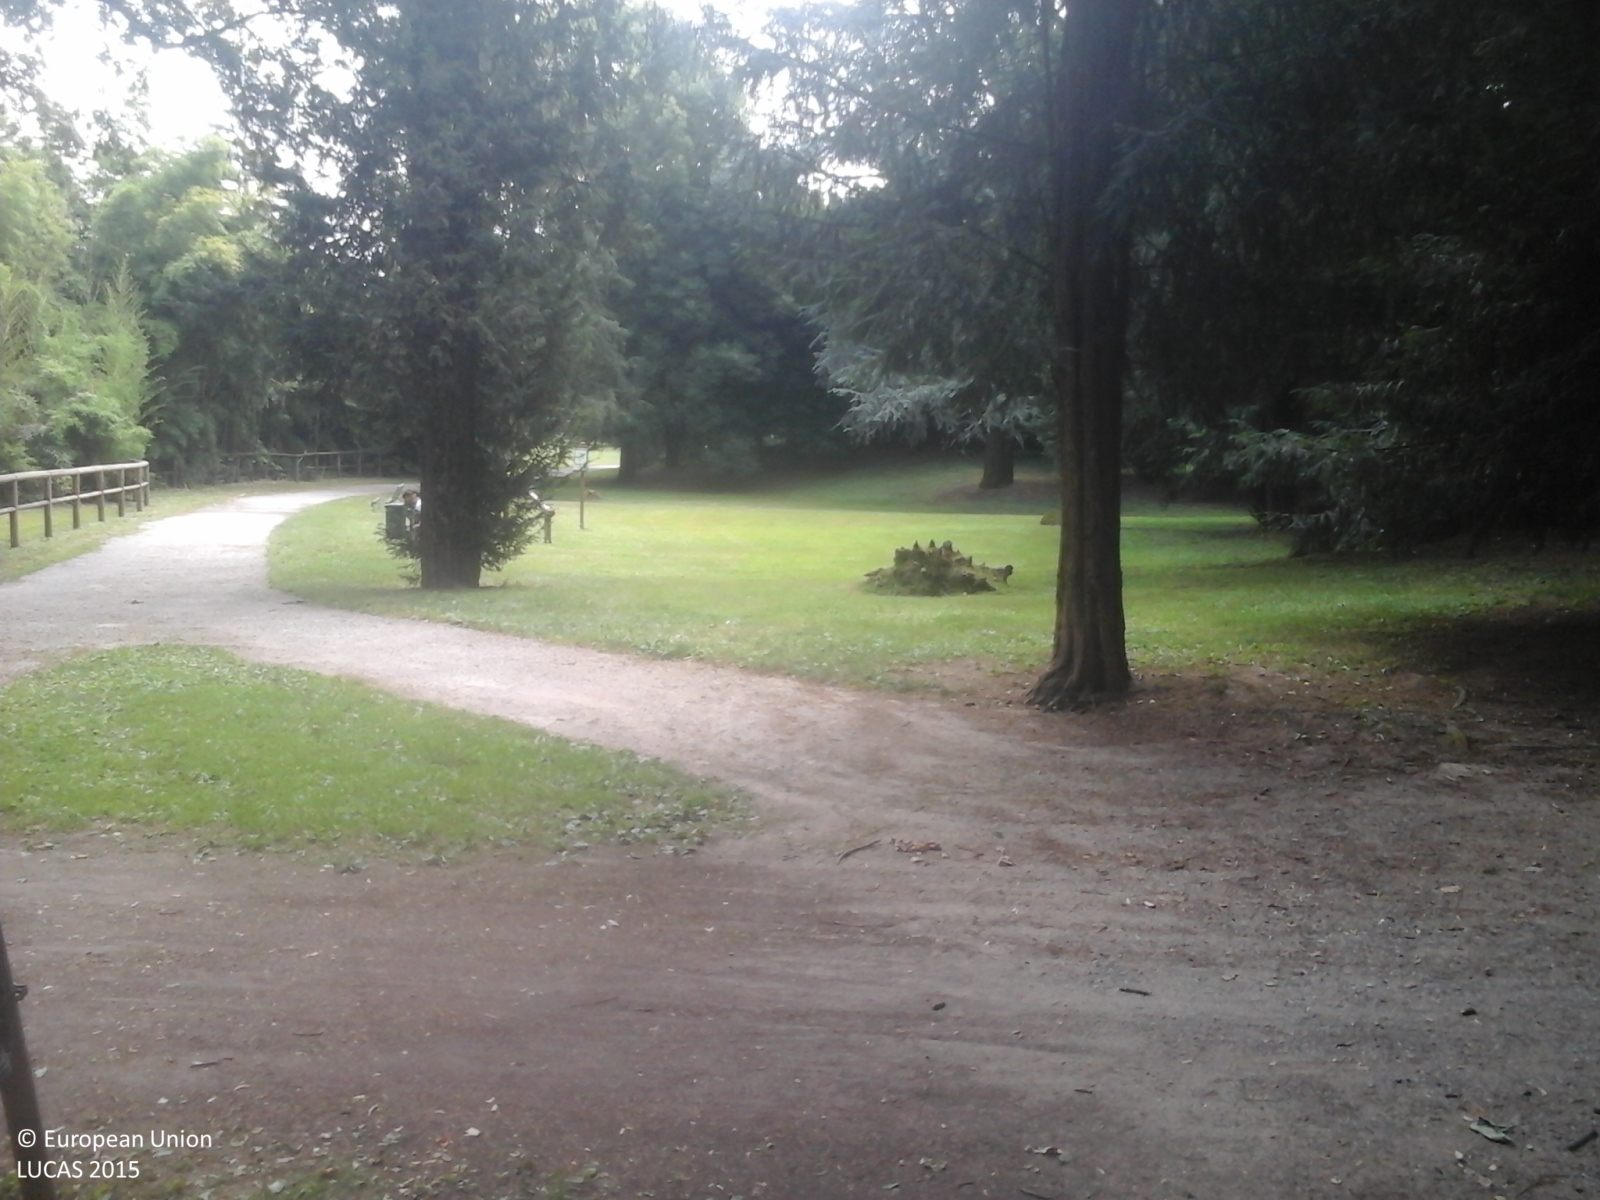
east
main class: Woodland
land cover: Other mixed woodland
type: coniferous forest of the mediterranean region
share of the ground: > 75 %
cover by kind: coniferous forest trees 55 %, broadleaved forest trees 45 %
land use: Amenities, museums, leisure
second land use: Sport
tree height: > 5 m
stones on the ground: 25 - 50 %
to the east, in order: Other mixed woodland; Tracks; Grassland with sparse tree/shrub cover; Tracks; Other mixed woodland; Tracks; Other mixed woodland; Fences; Paved roads, cycling and walking lanes; Abandoned hedges; Inland fresh running water; Abandoned hedges; Artificial constructions in urban areas
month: June
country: IT
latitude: 45.6107
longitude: 9.3727
